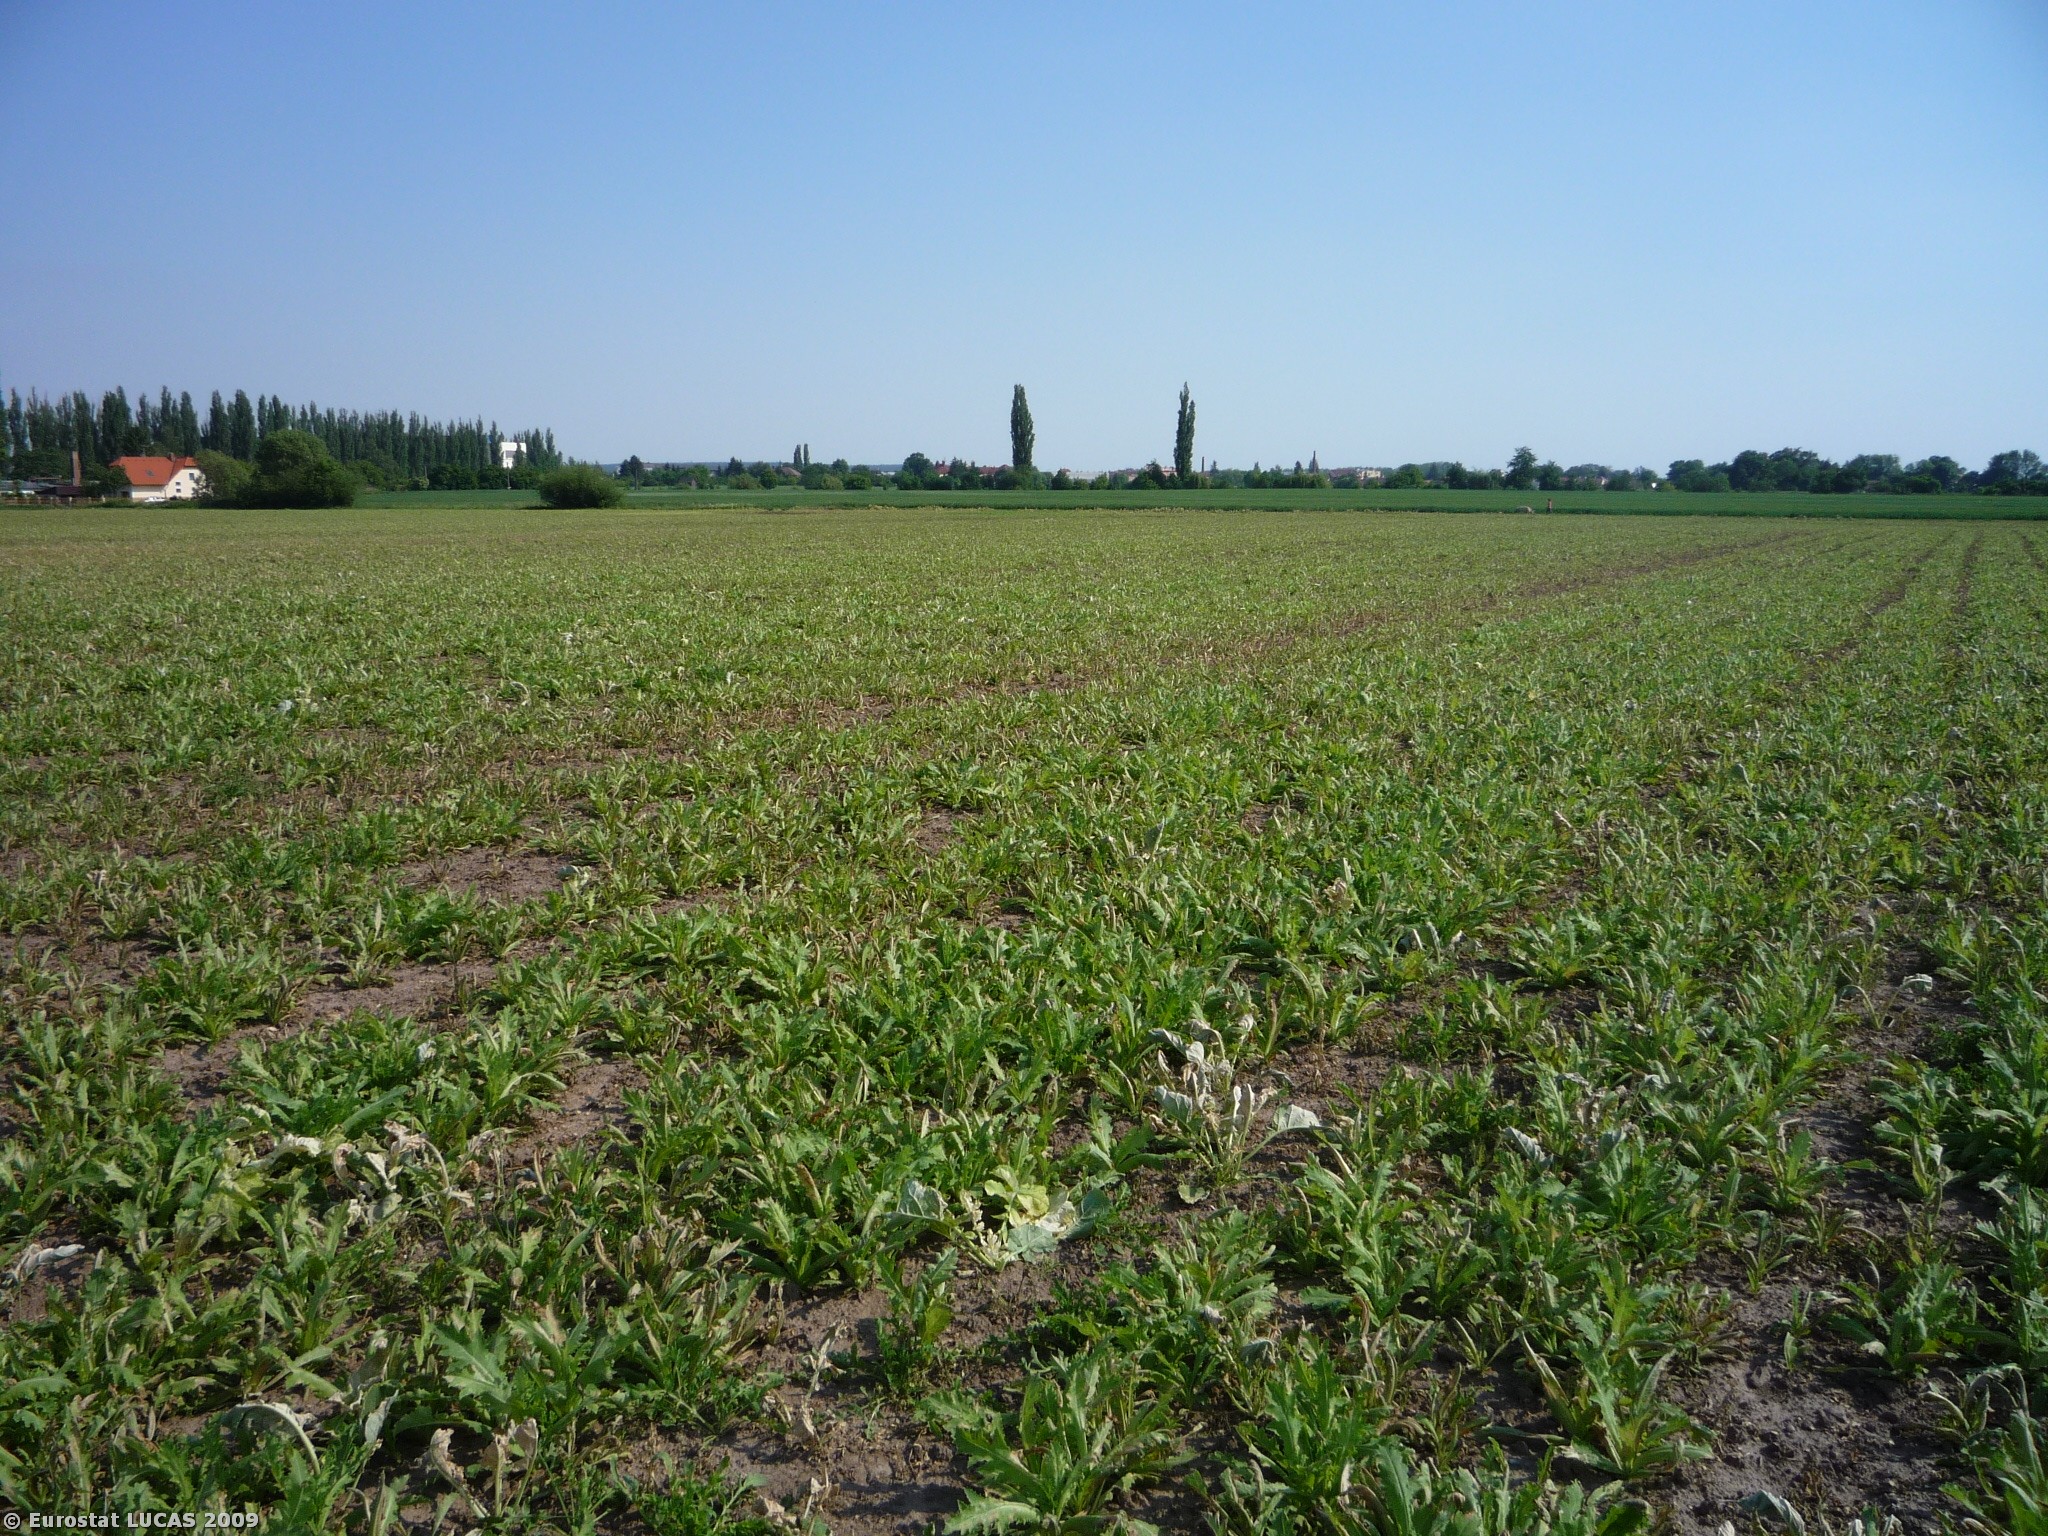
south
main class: Cropland
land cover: Other fibre and oleaginous crops
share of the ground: > 75 %
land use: Agriculture (excluding fallow land and kitchen gardens)
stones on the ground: < 10 %
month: May
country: CZ
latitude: 50.2173
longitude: 15.7930
